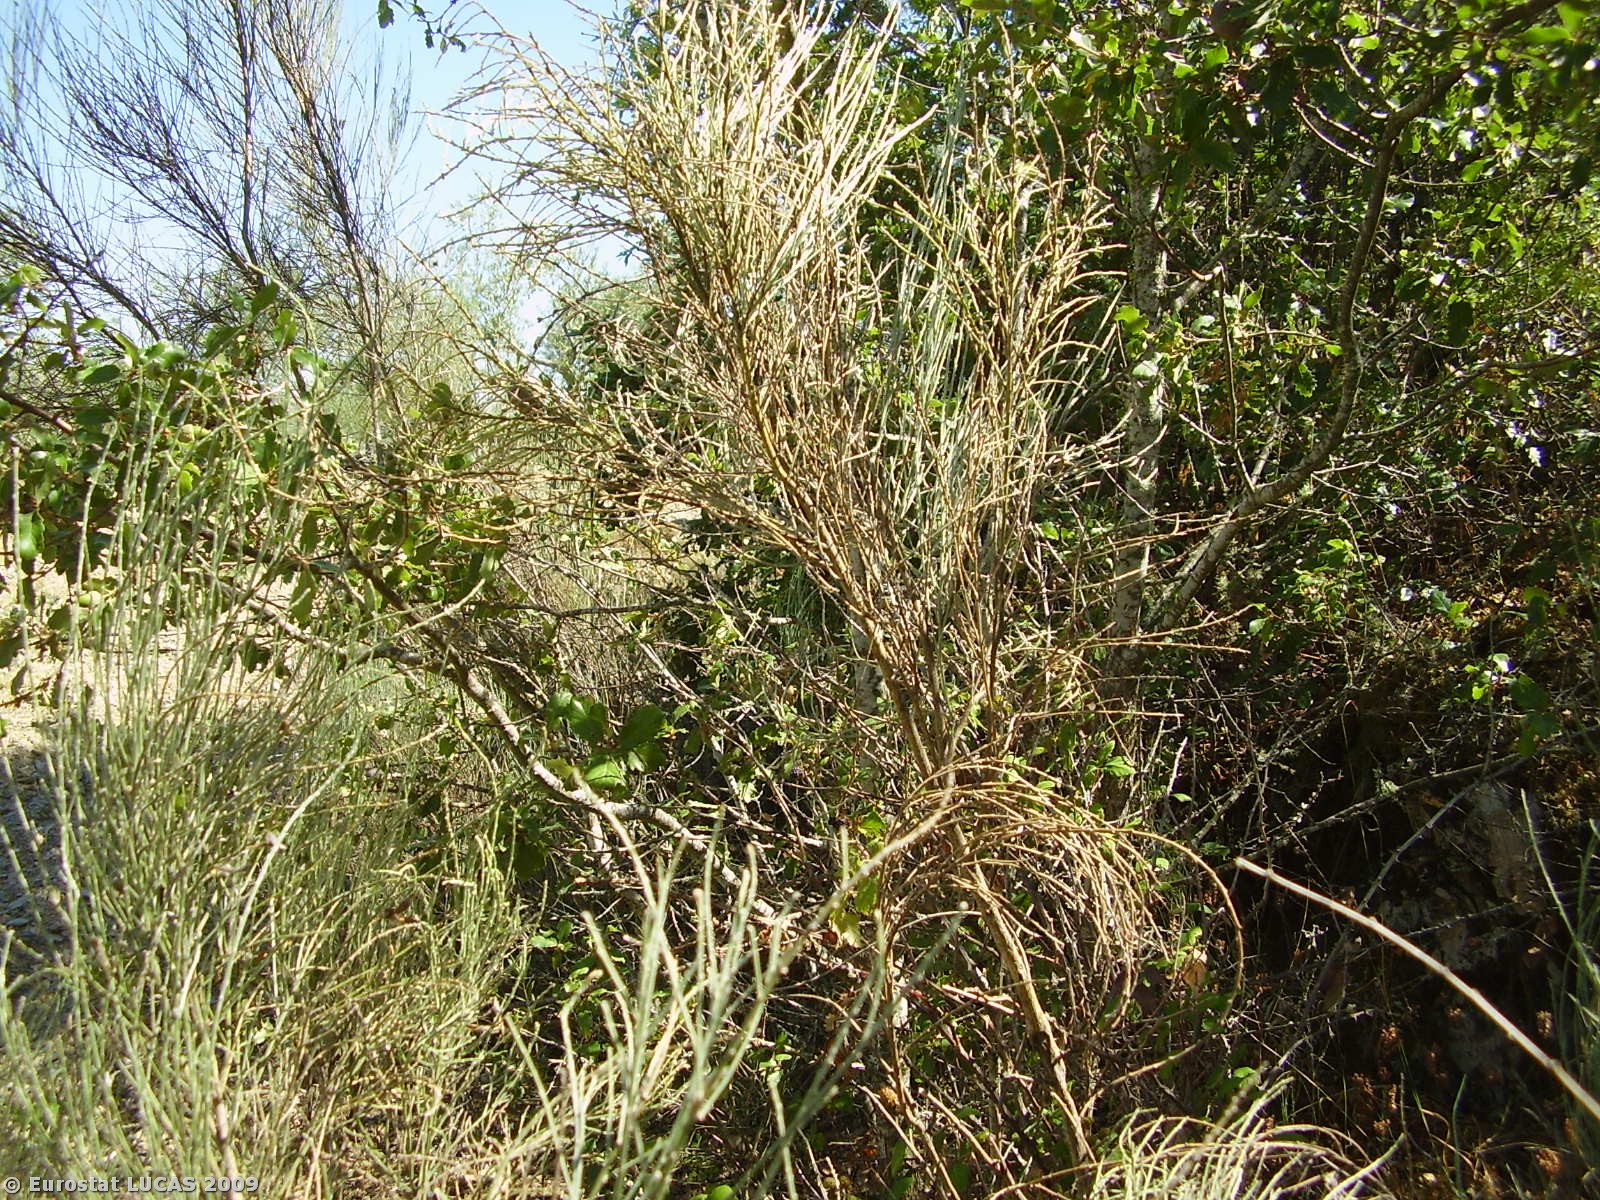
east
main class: Cropland
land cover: Olive groves
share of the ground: 50 - 75 %
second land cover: Bare land
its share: > 75 %
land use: Agriculture (excluding fallow land and kitchen gardens)
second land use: Fallow land
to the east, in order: Broadleaved woodland; Shrubland with sparse tree cover; Broadleaved woodland; Olive groves; Dry stone walls; Olive groves; Ditches and canals; Olive groves; Dry stone walls; Tracks; Shrubland without tree cover; Broadleaved woodland
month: August
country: PT
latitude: 41.1985
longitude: -6.7137
